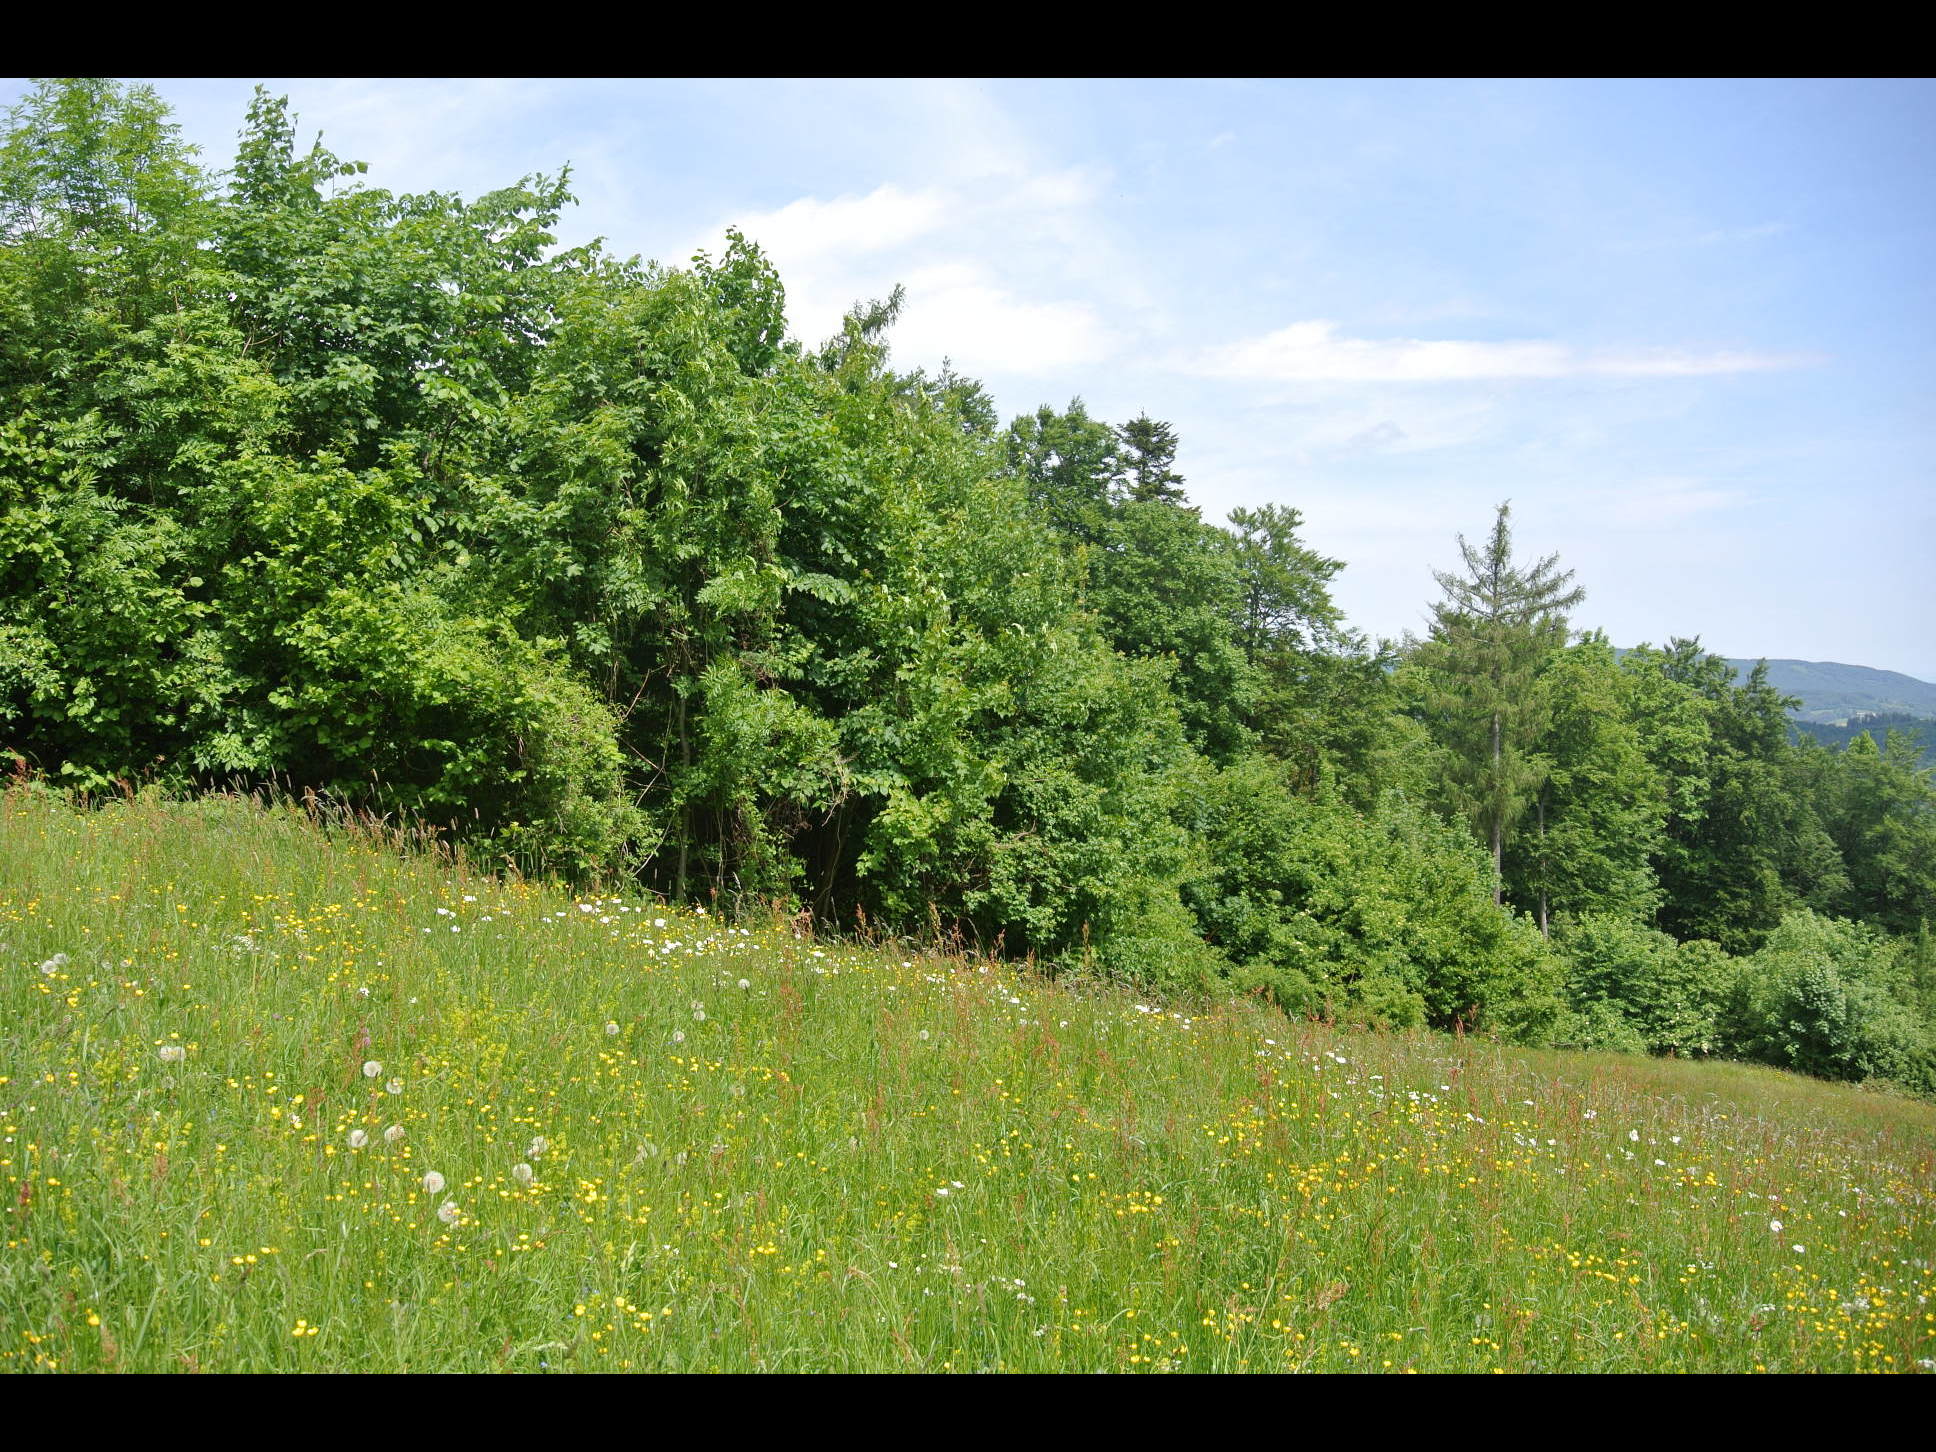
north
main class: Grassland
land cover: Grassland without tree/shrub cover
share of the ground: > 75 %
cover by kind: herbaceous plants 100 %
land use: Agriculture (excluding fallow land and kitchen gardens)
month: May
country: AT
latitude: 47.9998
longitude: 15.7792
